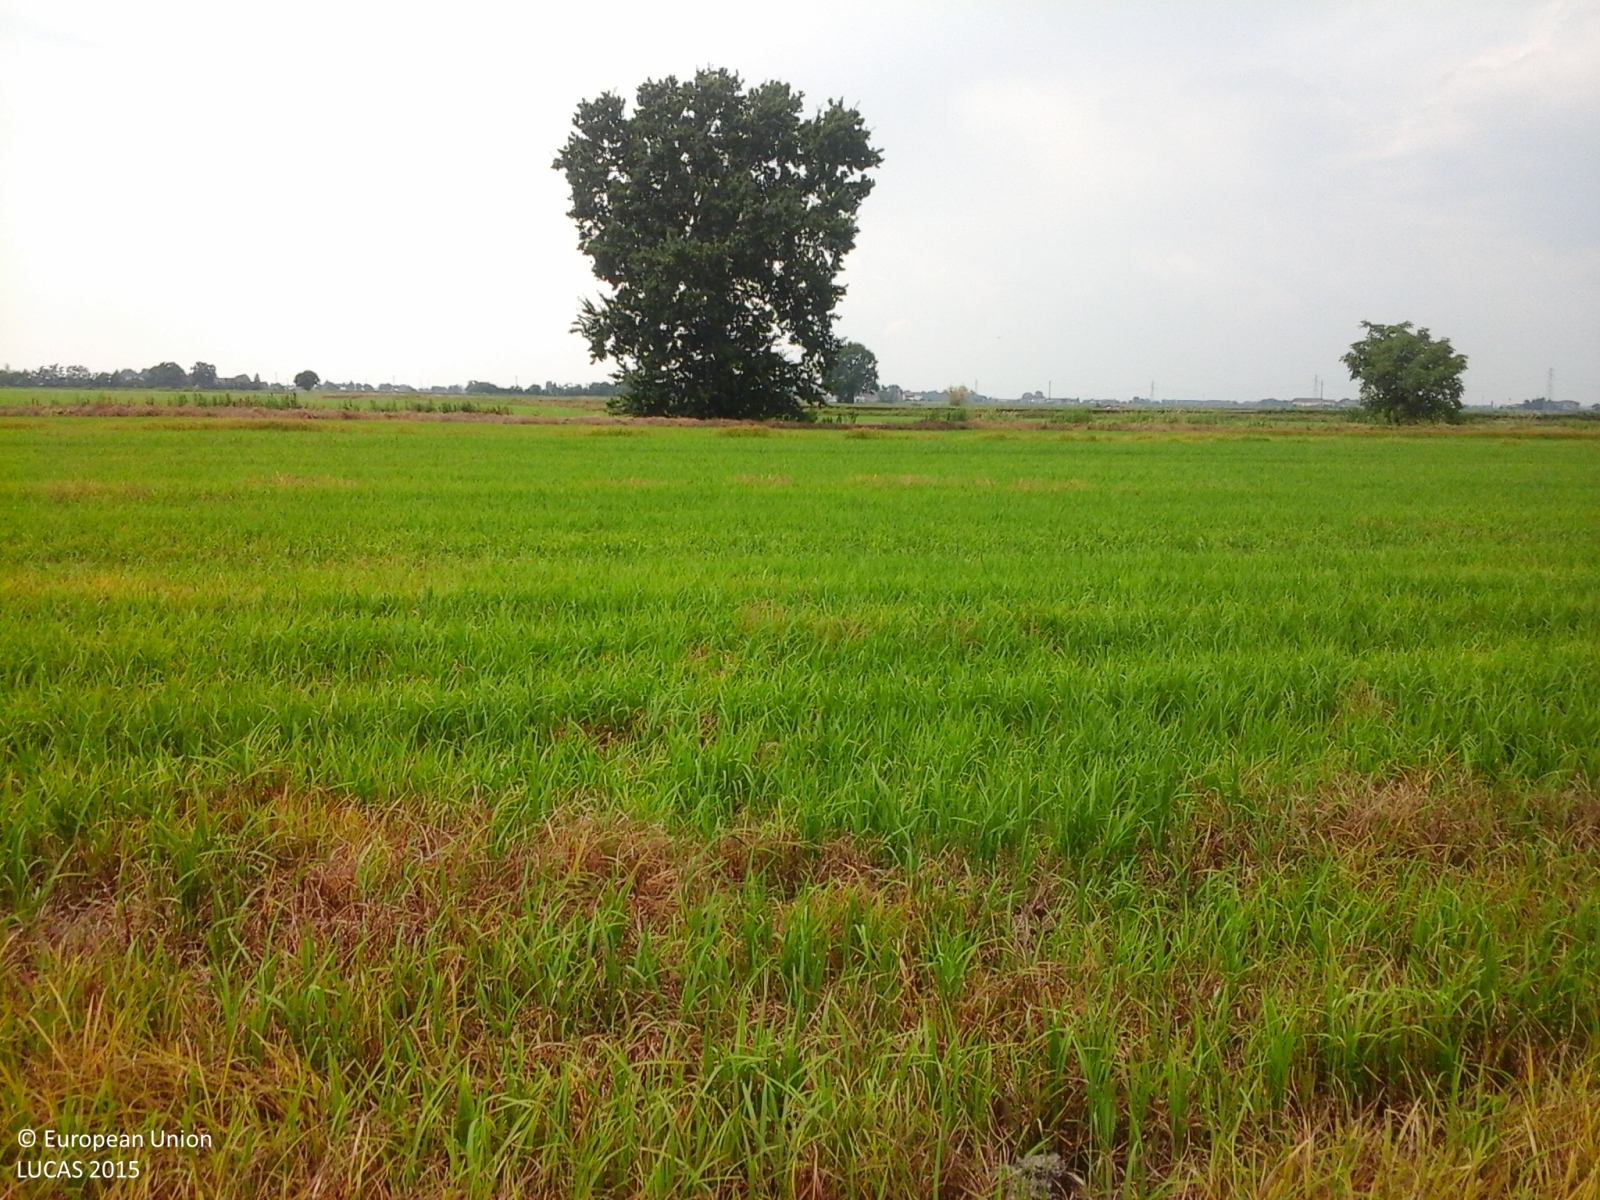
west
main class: Cropland
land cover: Rice
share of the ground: > 75 %
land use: Agriculture (excluding fallow land and kitchen gardens)
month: June
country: IT
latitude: 45.4048
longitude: 8.5843
